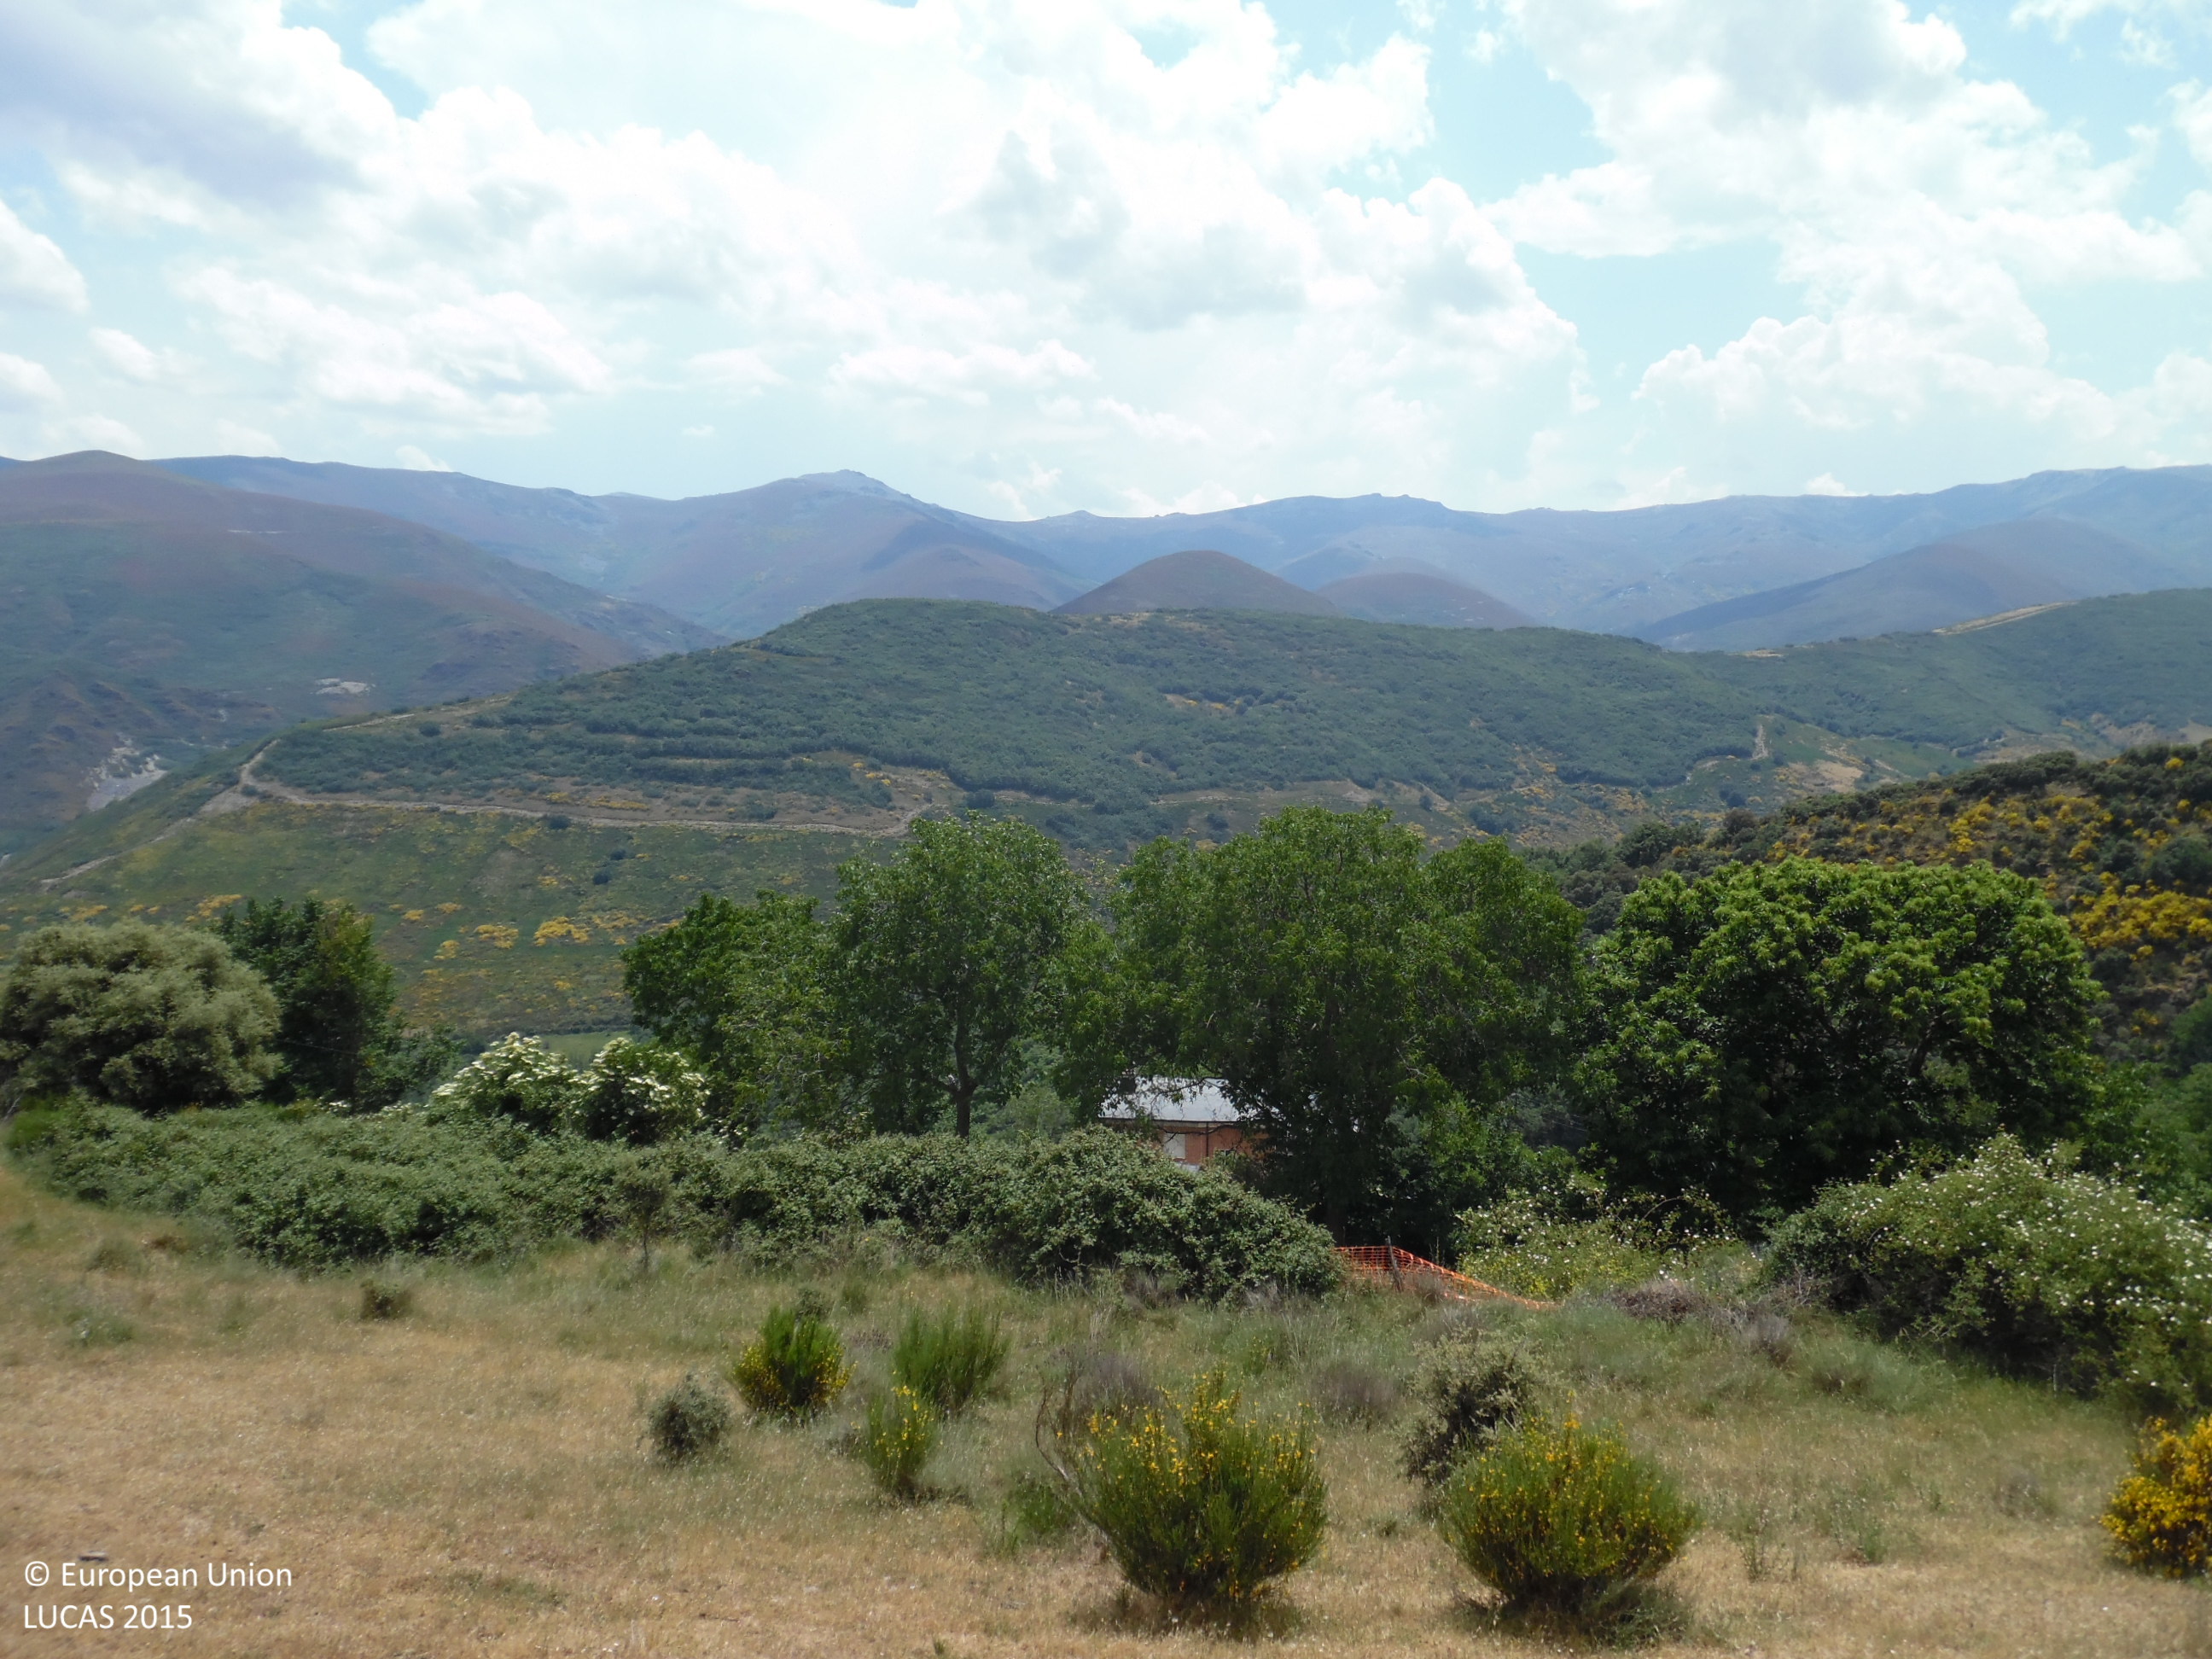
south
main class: Shrubland
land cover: Shrubland without tree cover
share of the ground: > 75 %
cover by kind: shrubs 90 %, unconsolidated bare surface 10 %
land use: Abandoned areas
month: June
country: ES
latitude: 42.2894
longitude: -6.5731
